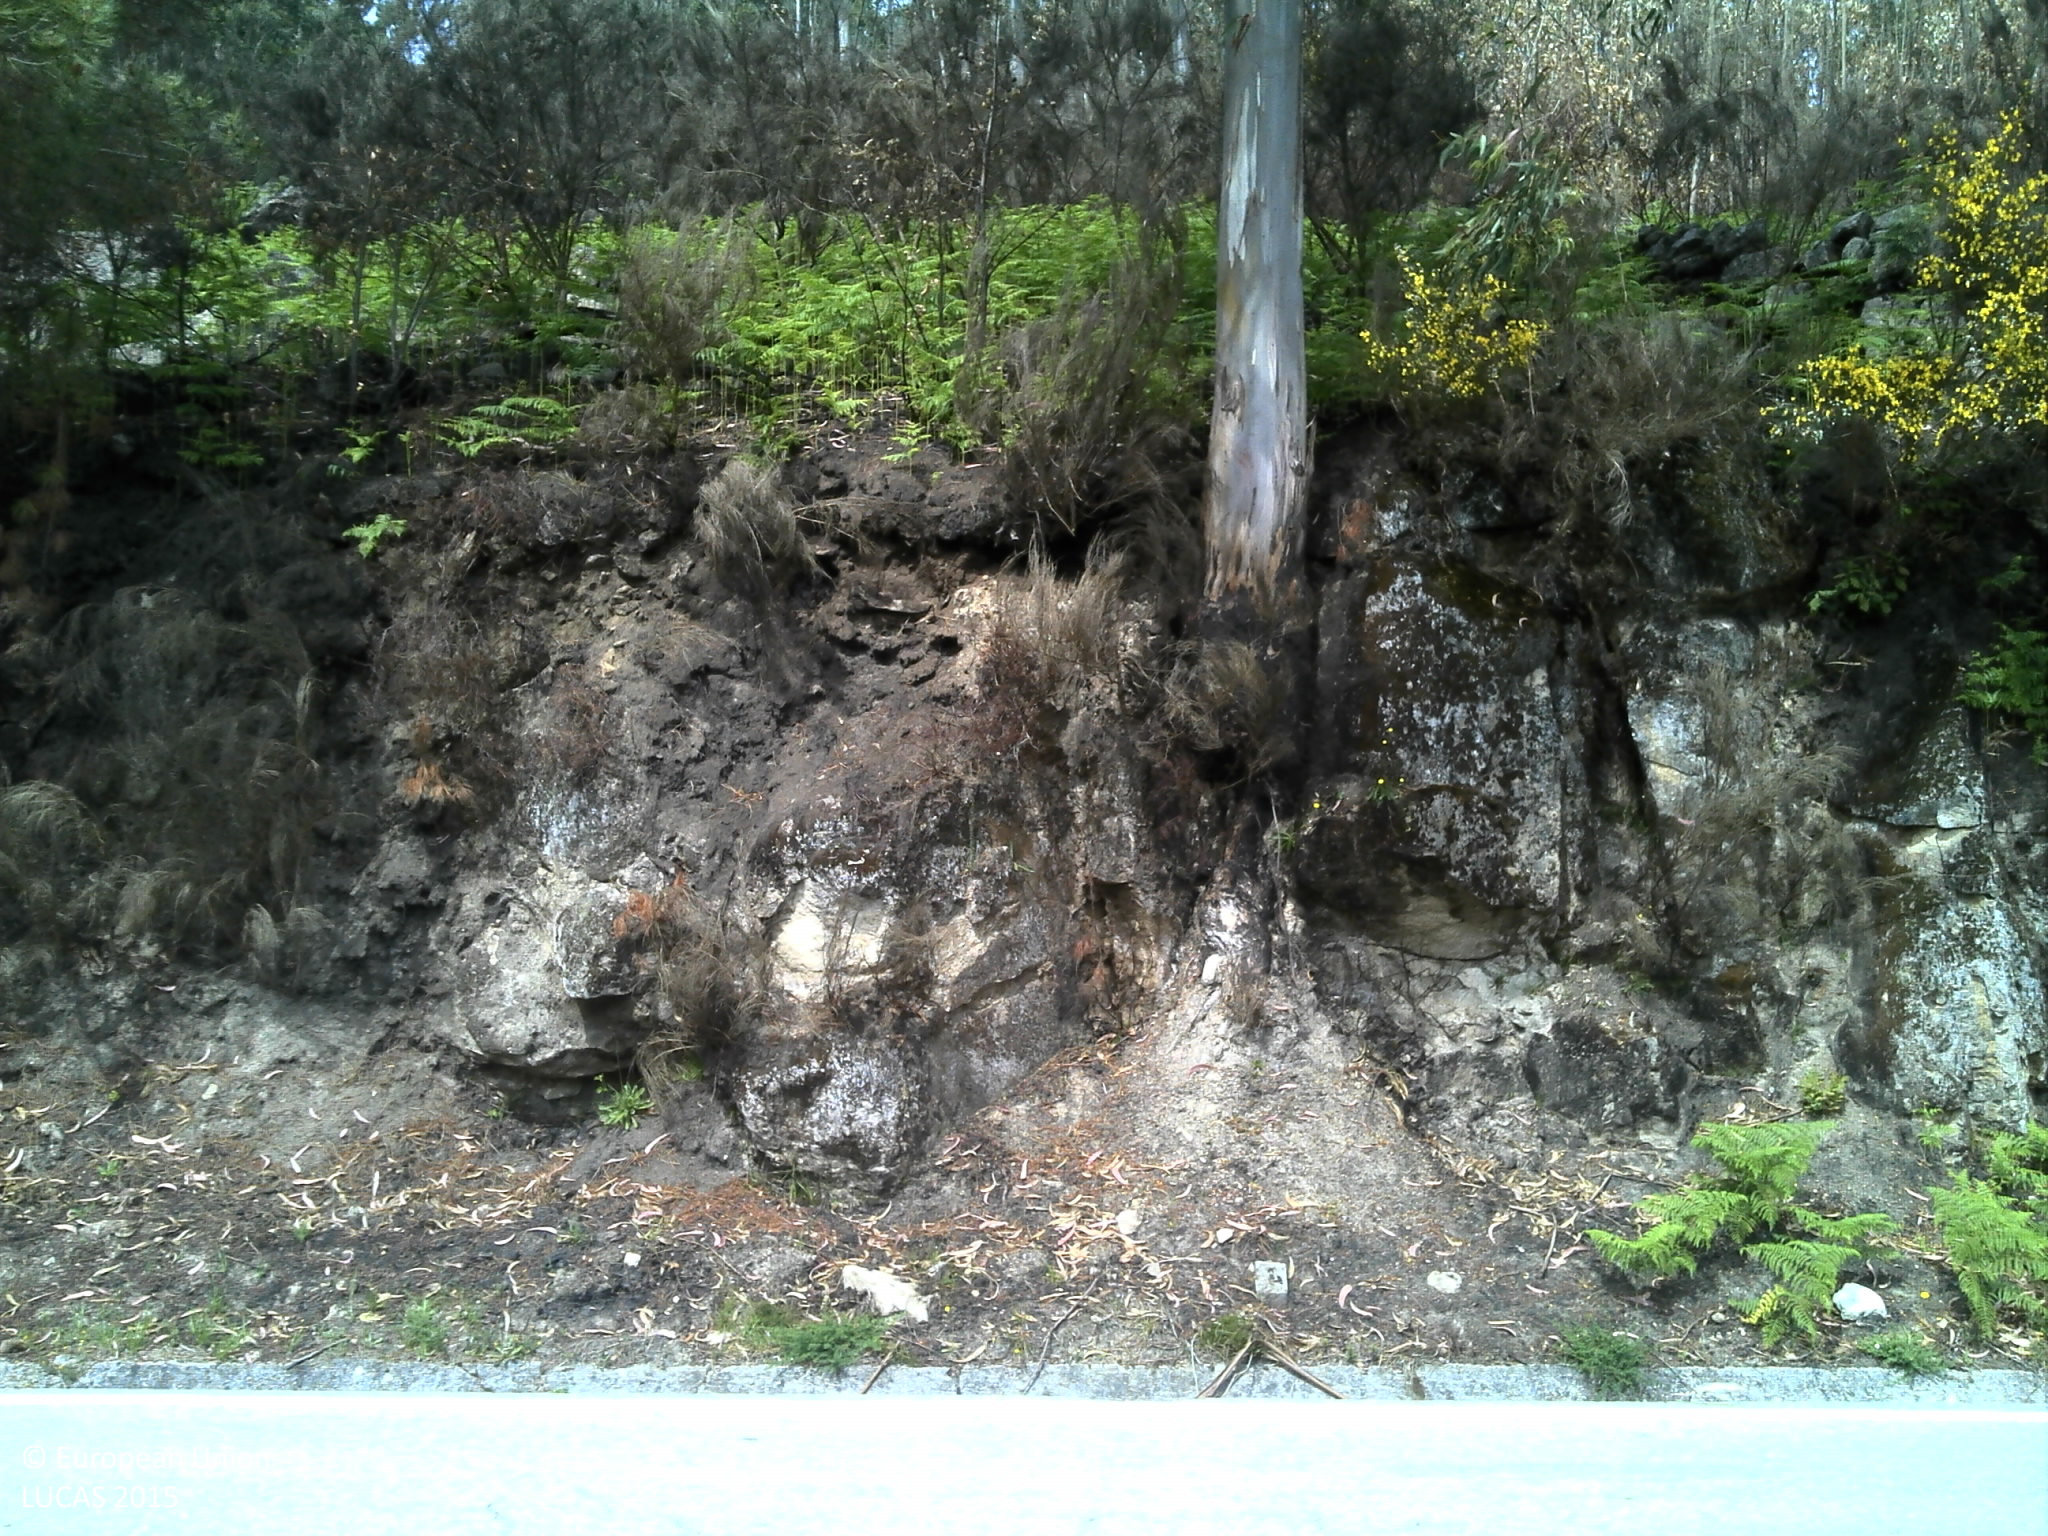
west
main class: Shrubland
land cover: Shrubland without tree cover
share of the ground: 50 - 75 %
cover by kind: shrubs 75 %, herbaceous plants 10 %, consolidated bare surface 10 %, unconsolidated bare surface 5 %
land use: Abandoned areas
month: May
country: PT
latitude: 41.0331
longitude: -8.0597
